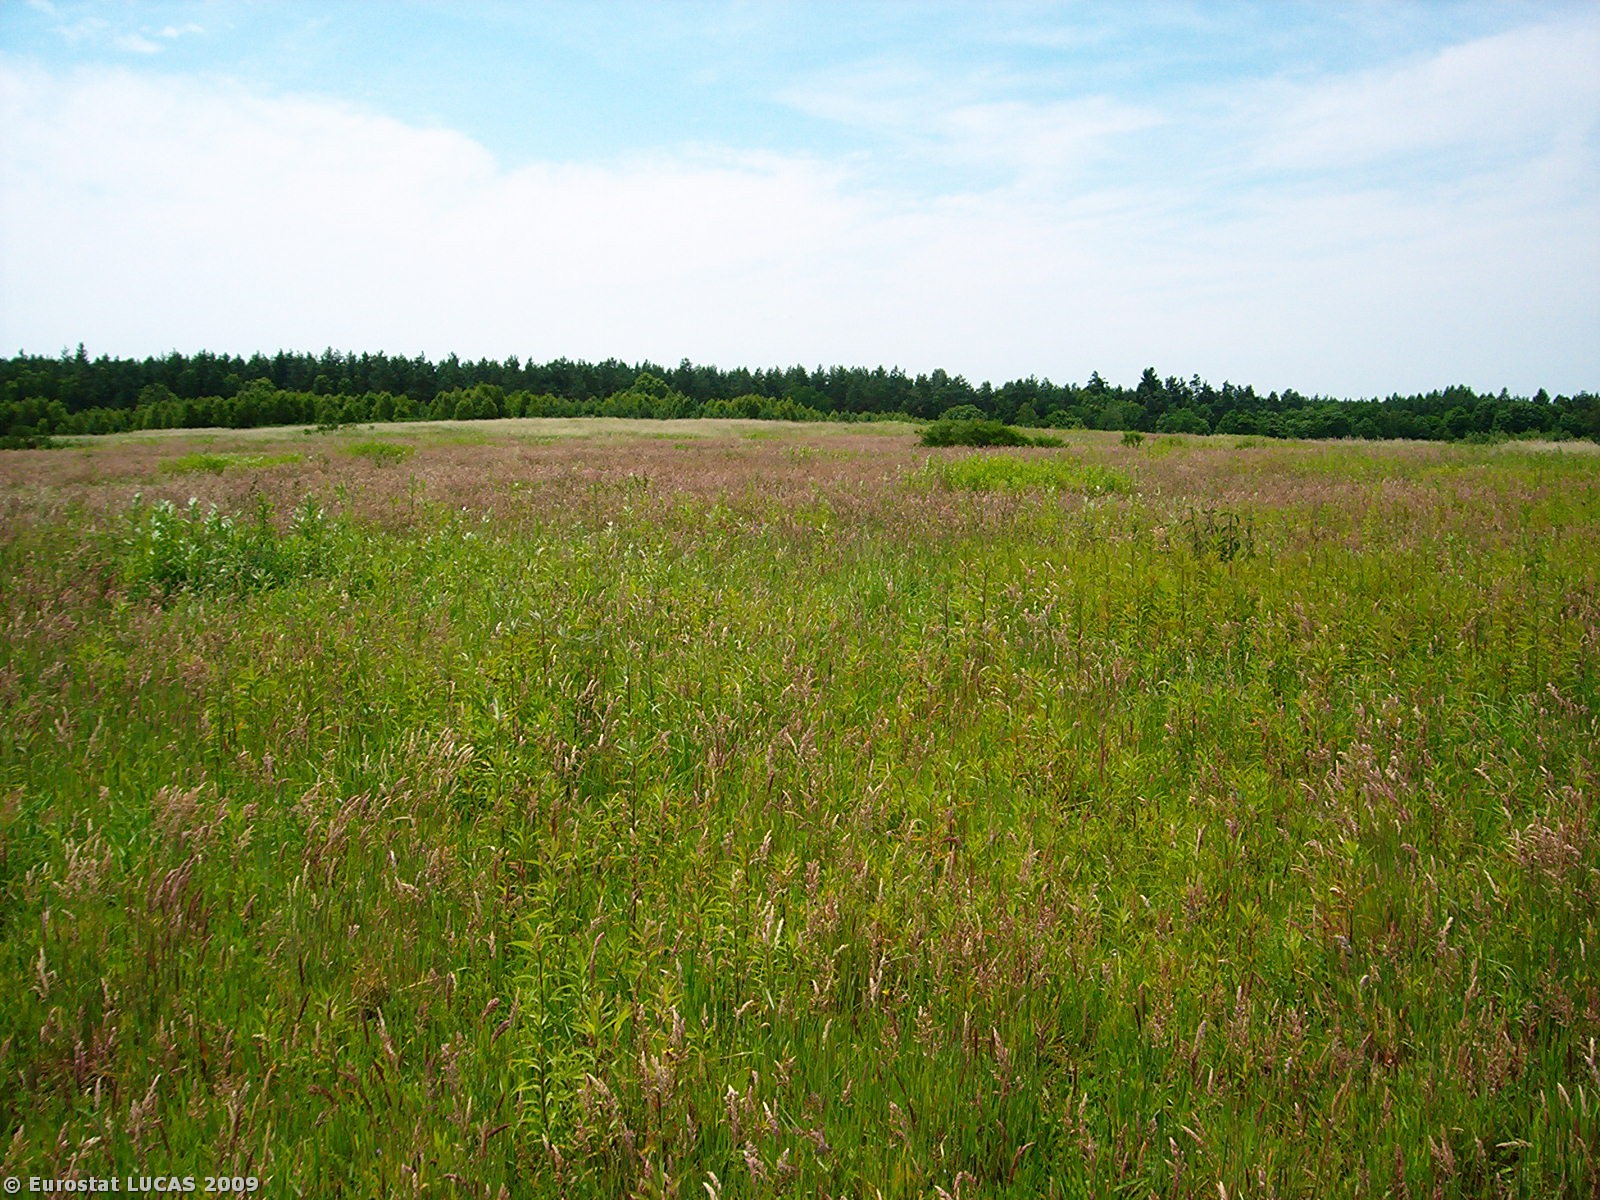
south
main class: Grassland
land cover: Grassland with sparse tree/shrub cover
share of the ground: > 75 %
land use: Unused
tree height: < 5 m
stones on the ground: < 10 %
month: June
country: PL
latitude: 53.8361
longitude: 15.4888
